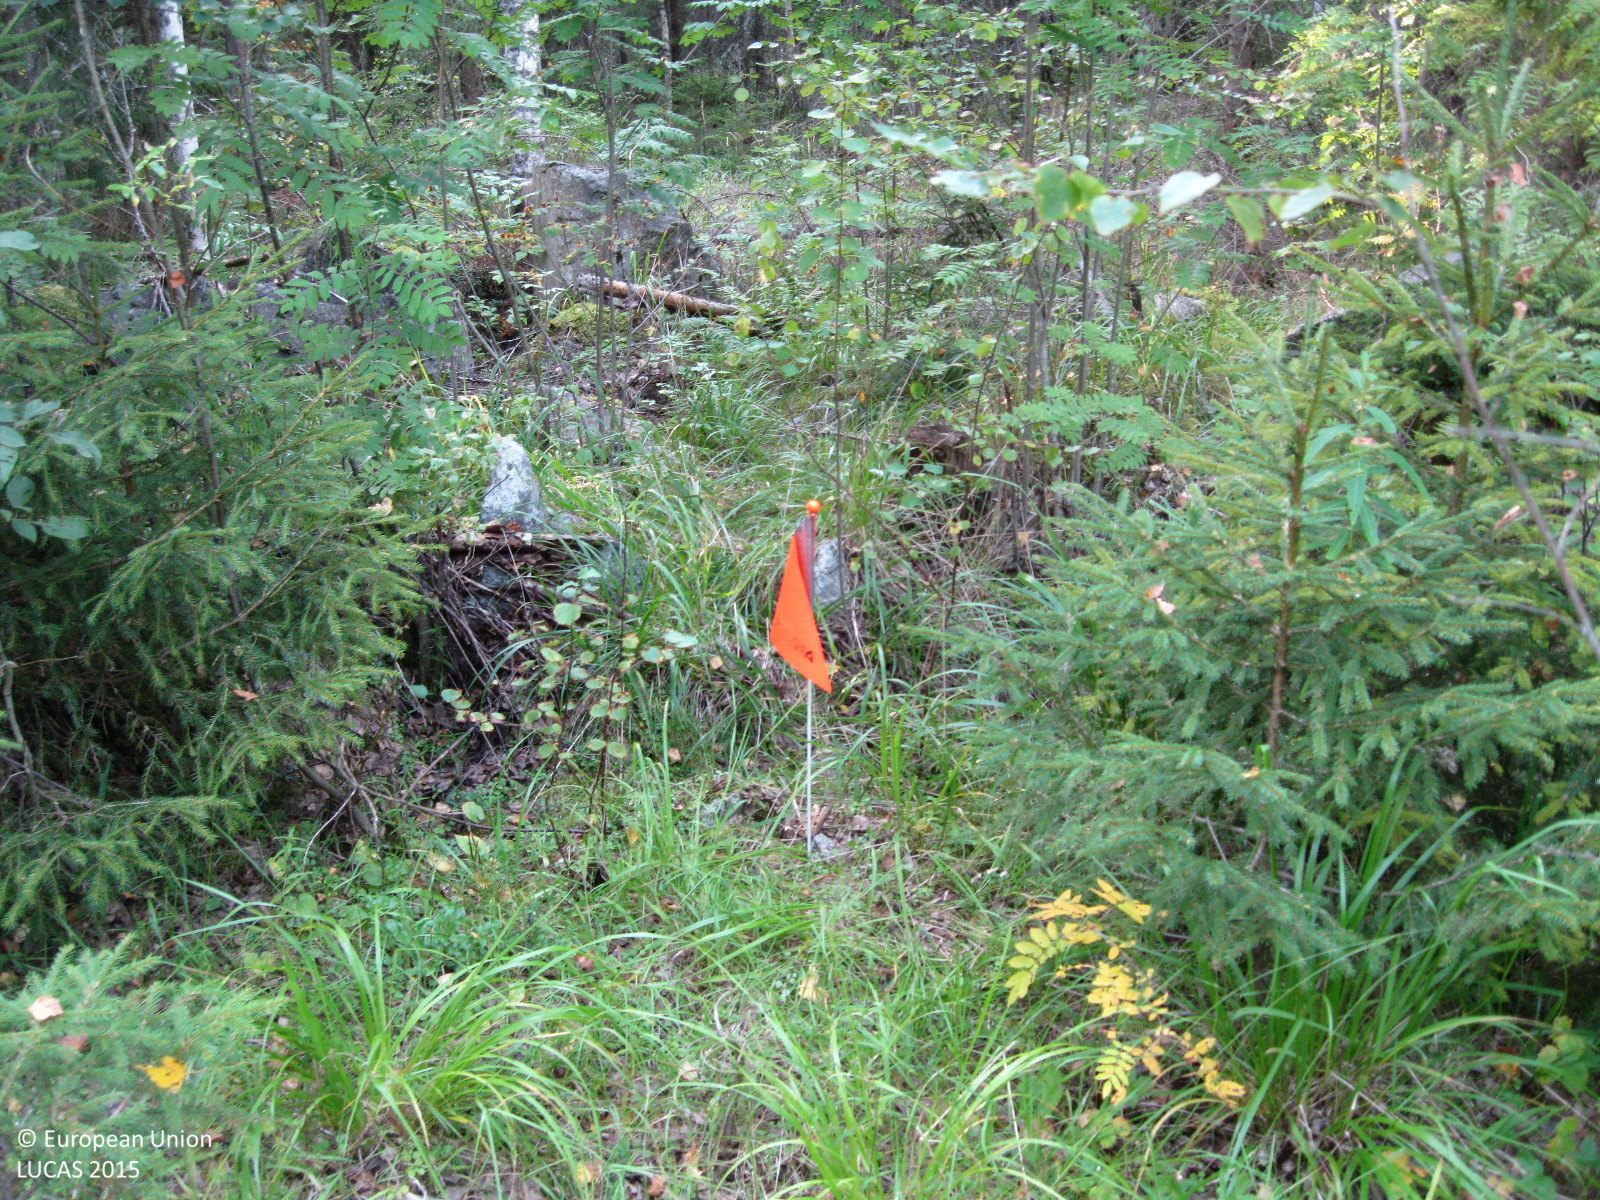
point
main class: Woodland
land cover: Spruce dominated mixed woodland
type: boreal forest
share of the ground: 50 - 75 %
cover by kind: coniferous forest trees 50 %, herbaceous plants 30 %, broadleaved forest trees 20 %
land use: Forestry
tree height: > 5 m
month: August
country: FI
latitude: 61.3796
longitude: 25.1414
